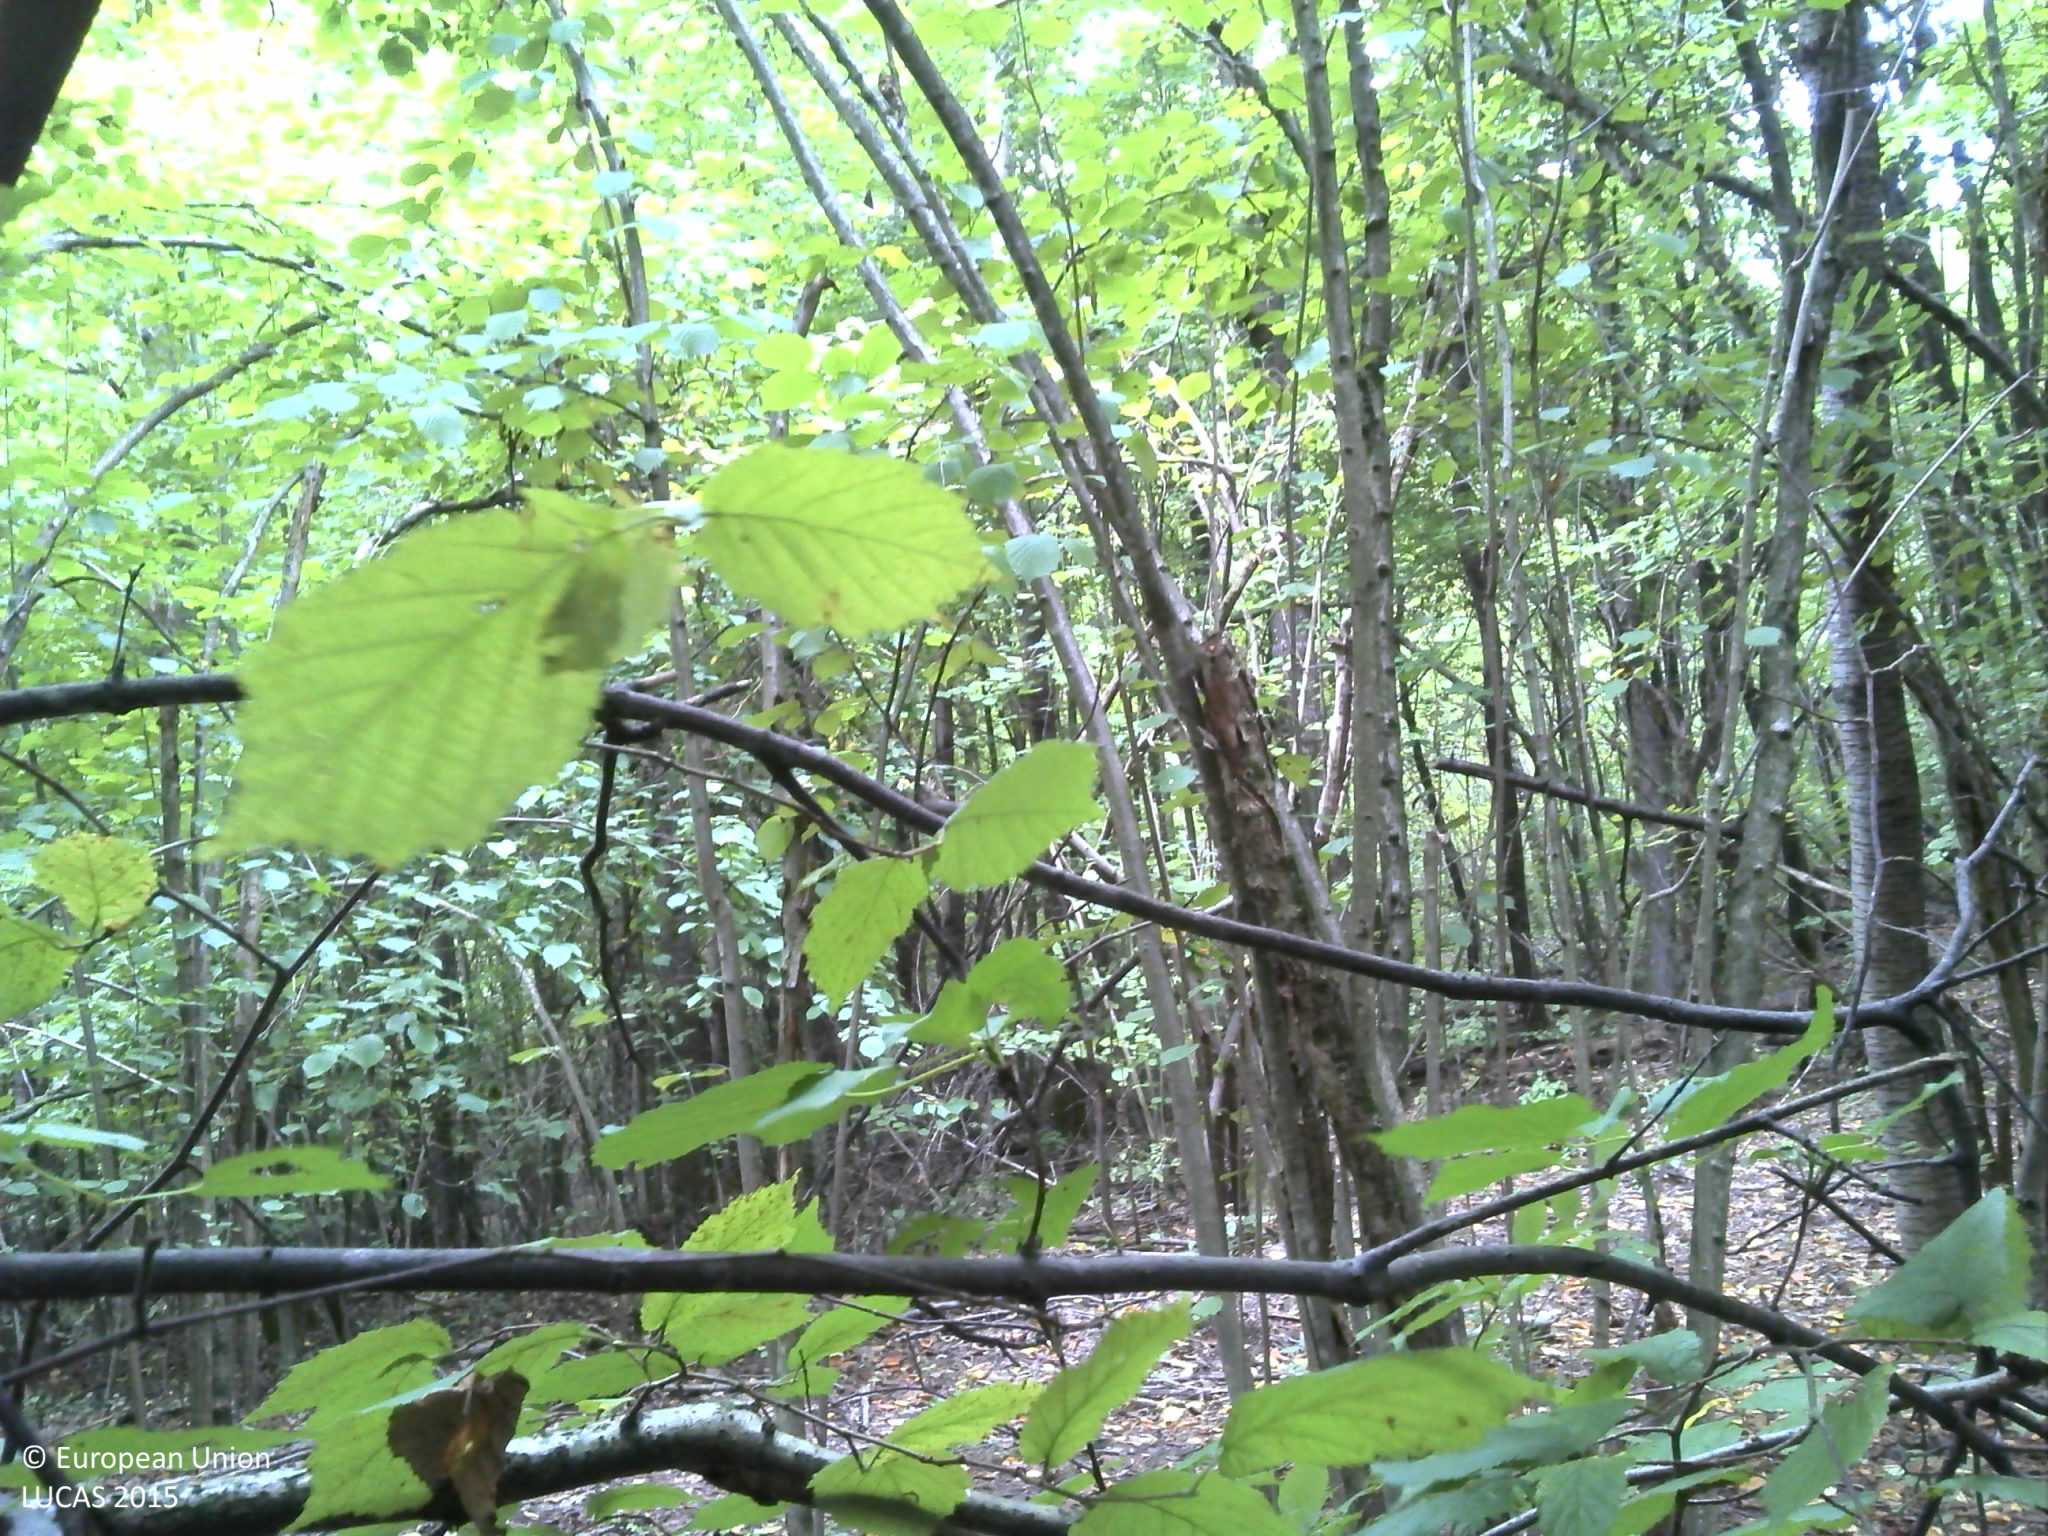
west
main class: Woodland
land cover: Broadleaved woodland
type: acidophilous oak and oak-birch forest
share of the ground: > 75 %
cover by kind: broadleaved forest trees 100 %
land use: Forestry
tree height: > 5 m
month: August
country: HR
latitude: 45.2234
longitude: 16.6328
